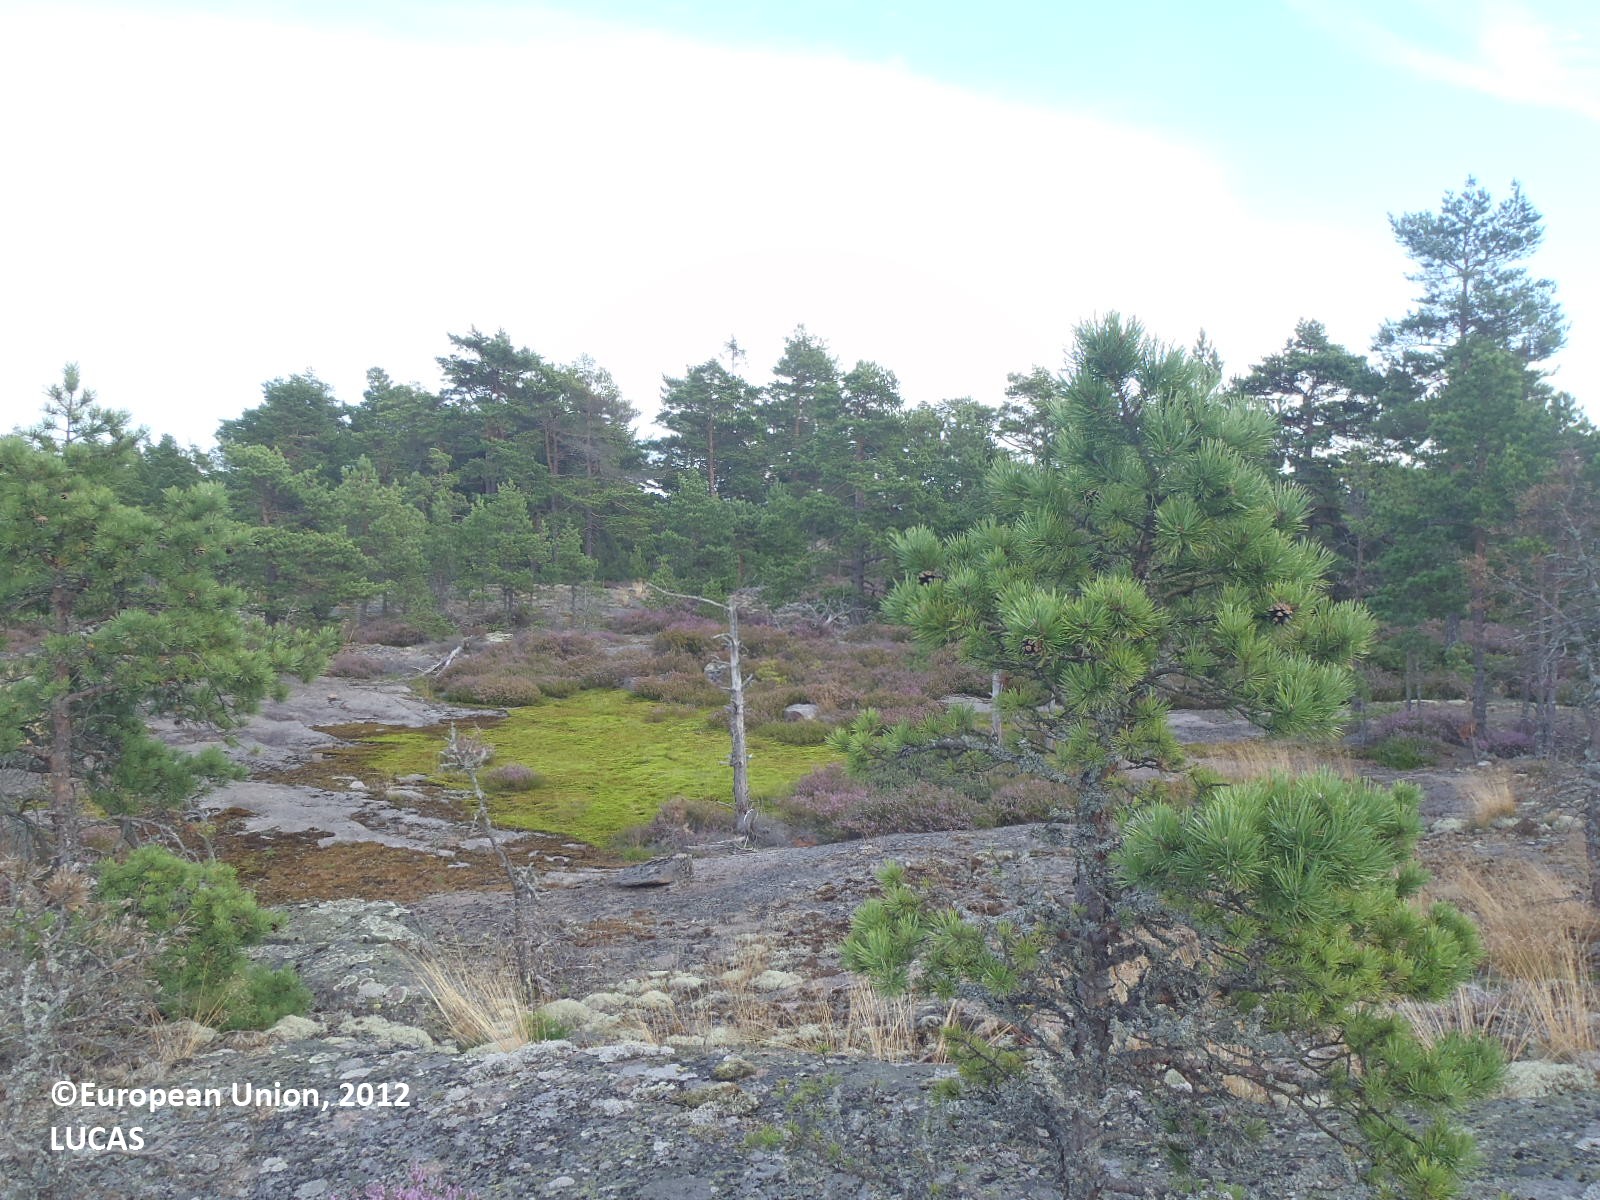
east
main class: Woodland
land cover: Pine dominated coniferous woodland
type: boreal forest
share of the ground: 10 - 25 %
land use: Semi-natural and natural areas not in use
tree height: > 5 m
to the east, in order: Pine dominated coniferous woodland; Lichens and moss; Shrubland without tree cover; Pine dominated coniferous woodland; Lichens and moss; Pine dominated coniferous woodland
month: August
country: FI
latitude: 60.3467
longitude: 20.3191
